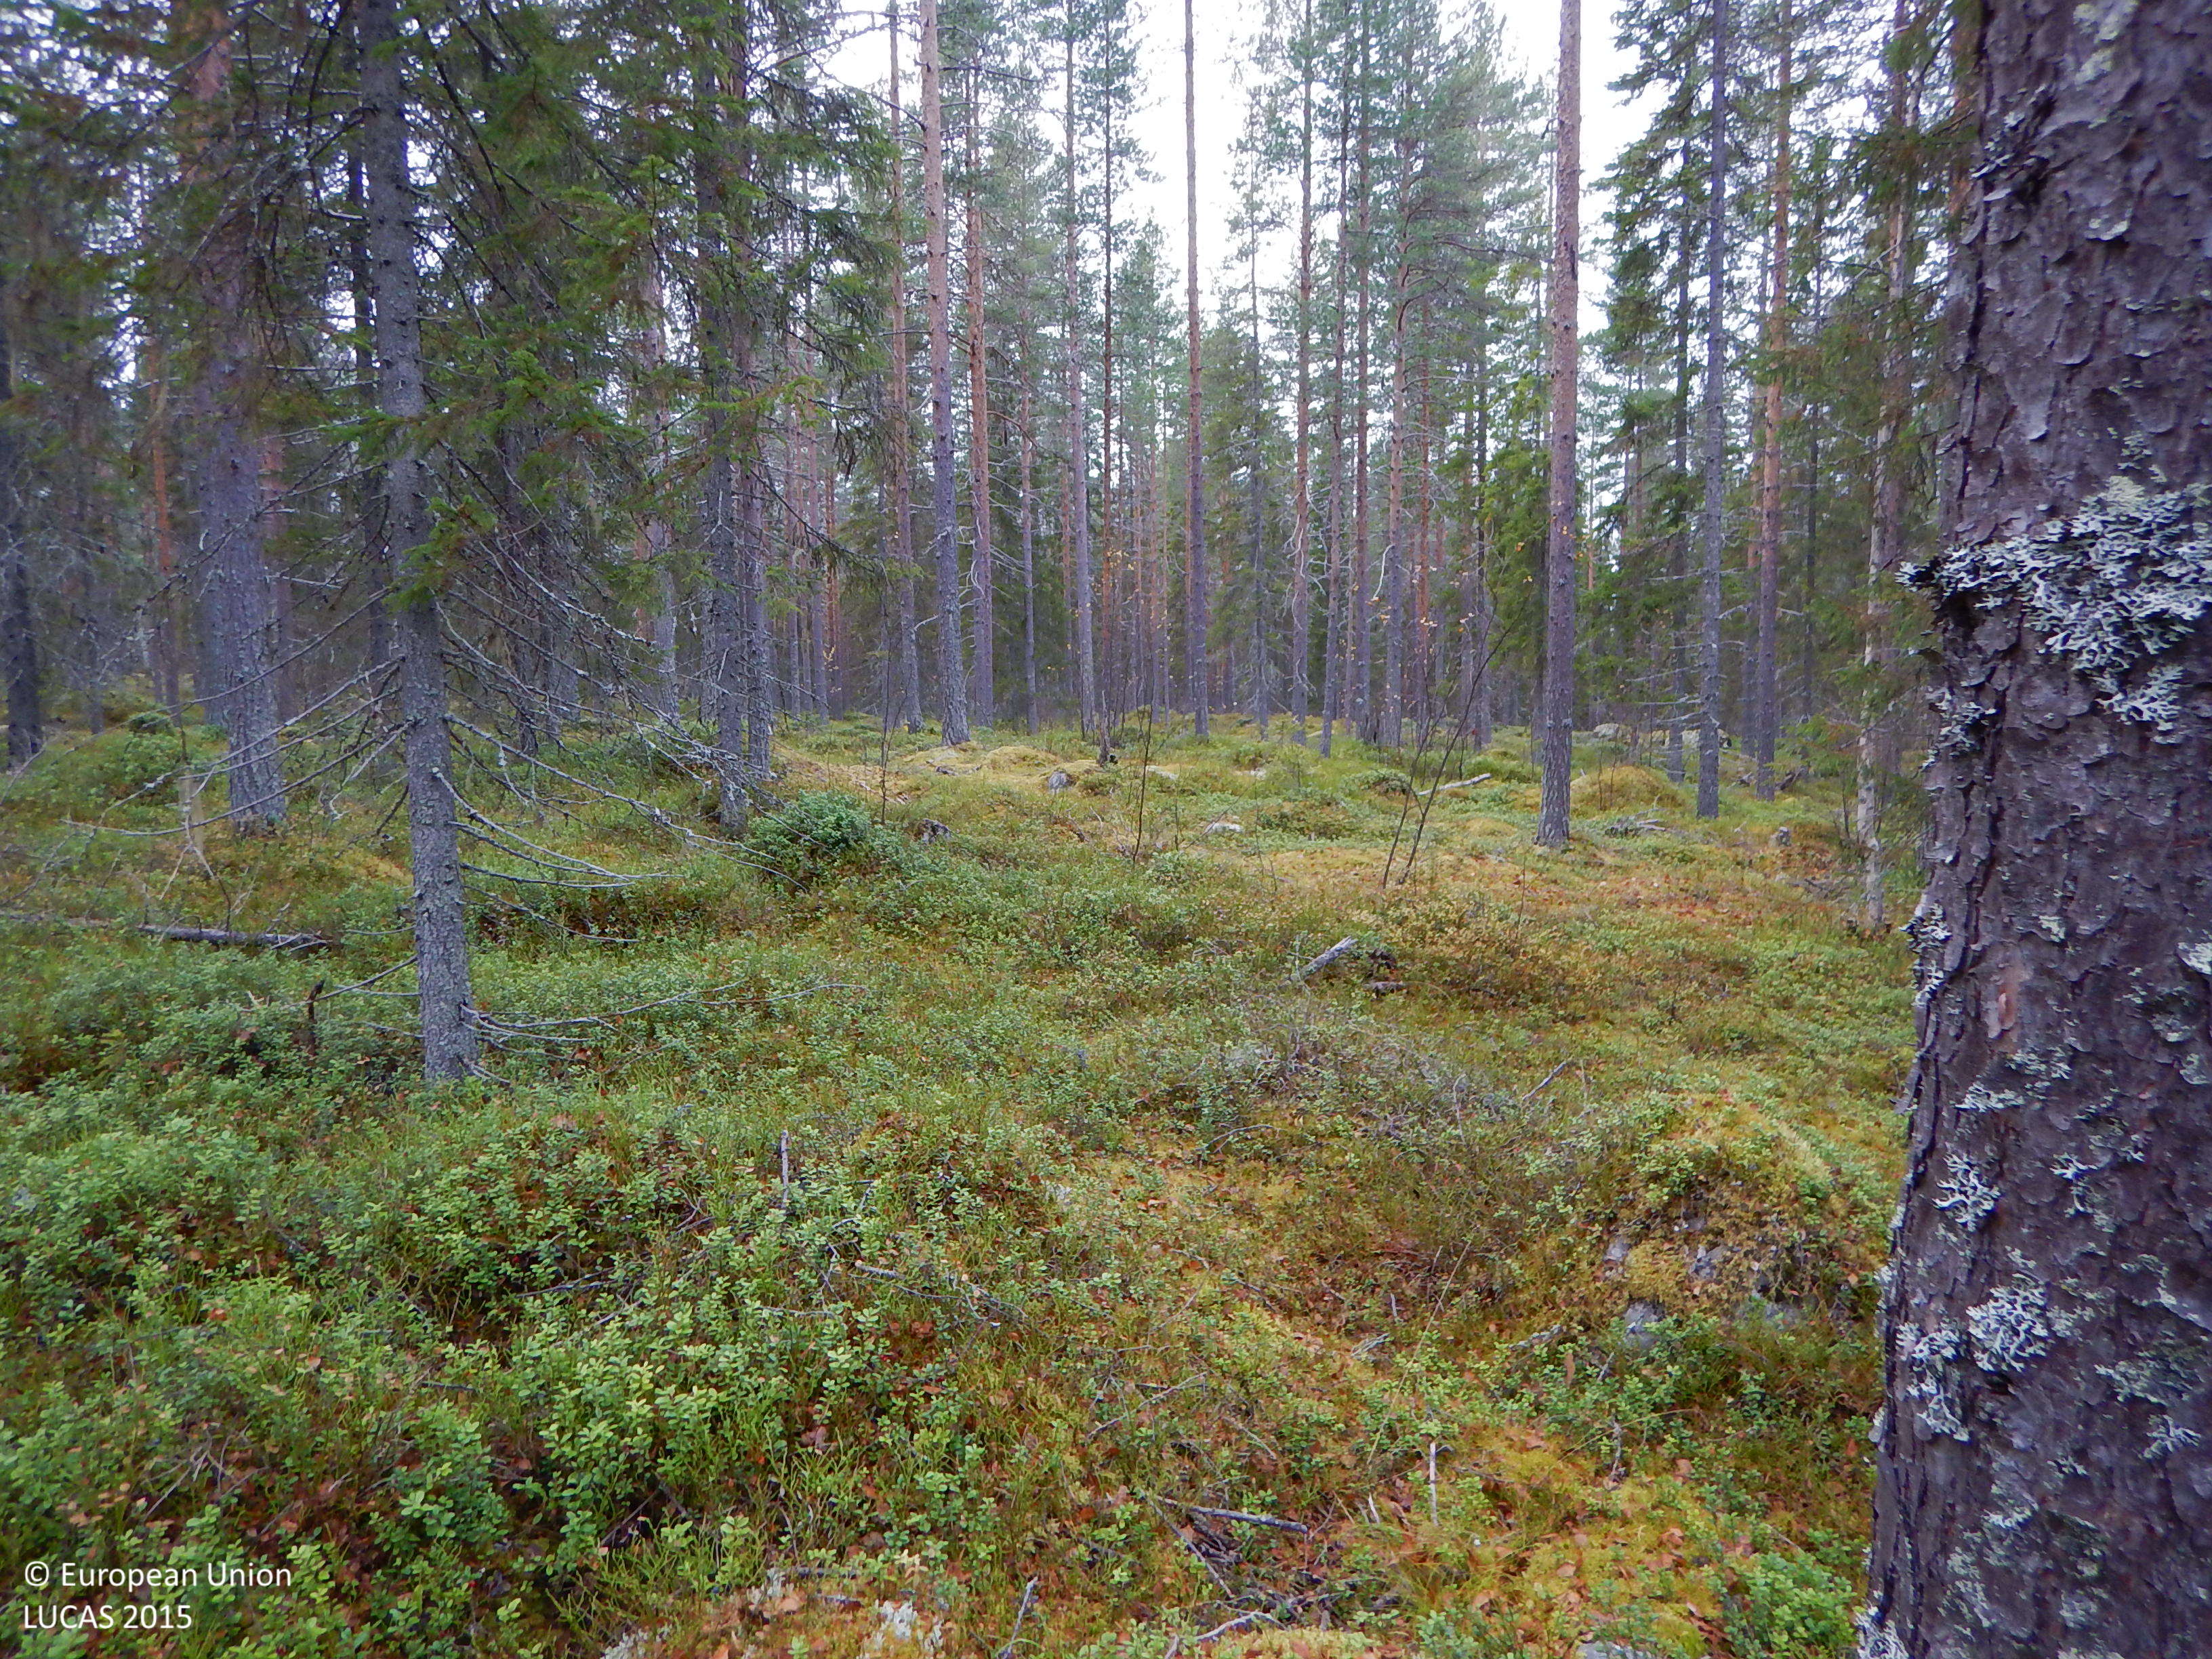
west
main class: Woodland
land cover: Pine dominated coniferous woodland
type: boreal forest
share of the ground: 50 - 75 %
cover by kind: coniferous forest trees 60 %, shrubs 20 %, lichens and mosses 10 %, broadleaved forest trees 5 %, herbaceous plants 5 %
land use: Forestry
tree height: > 5 m
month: October
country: SE
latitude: 65.1217
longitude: 21.1171
